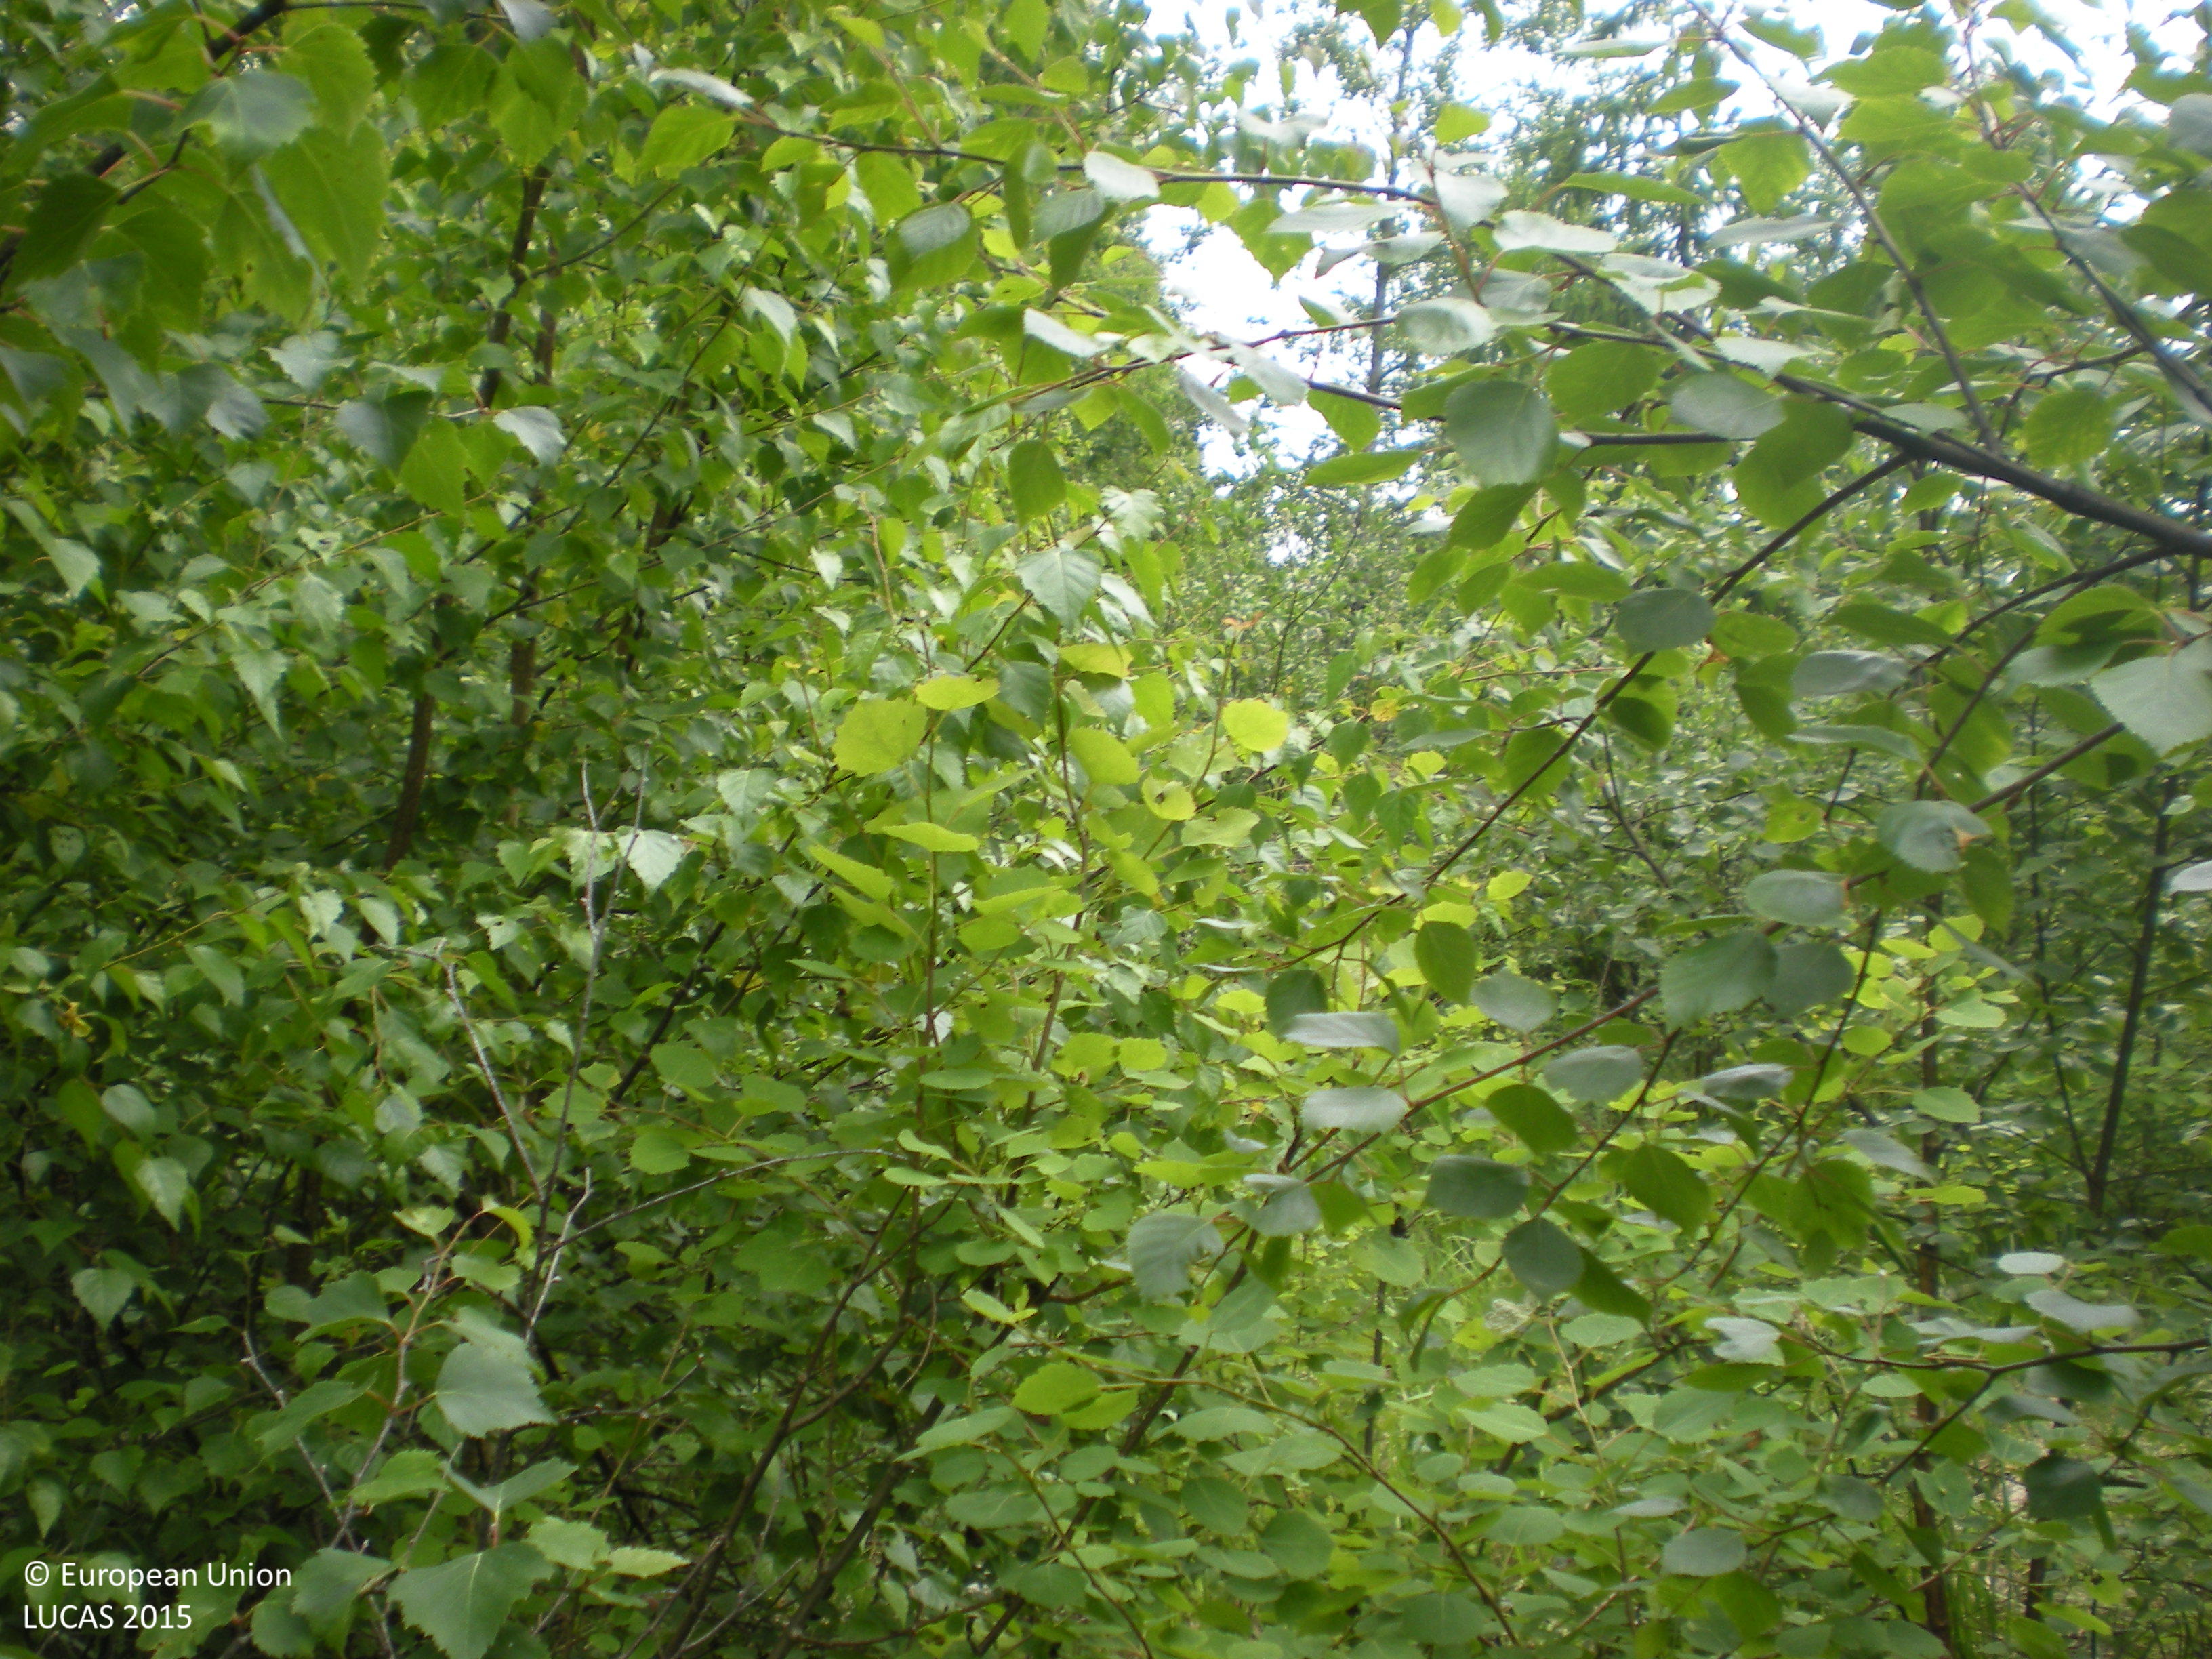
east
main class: Woodland
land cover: Broadleaved woodland
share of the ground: 50 - 75 %
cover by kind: broadleaved forest trees 65 %, herbaceous plants 15 %, shrubs 10 %, lichens and mosses 5 %
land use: Forestry
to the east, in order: Broadleaved woodland; Grassland without tree/shrub cover; Broadleaved woodland; Ditches and canals; Broadleaved woodland; Electric lines; Broadleaved woodland; Pine dominated mixed woodland; Pine dominated coniferous woodland; Pine dominated mixed woodland; Ditches and canals; Grass margins; Paved roads, cycling and walking lanes; Grass margins; Ditches and canals; Broadleaved woodland; Other coniferous woodland; Tracks; Other coniferous woodland
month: July
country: SE
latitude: 60.5551
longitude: 17.9250
